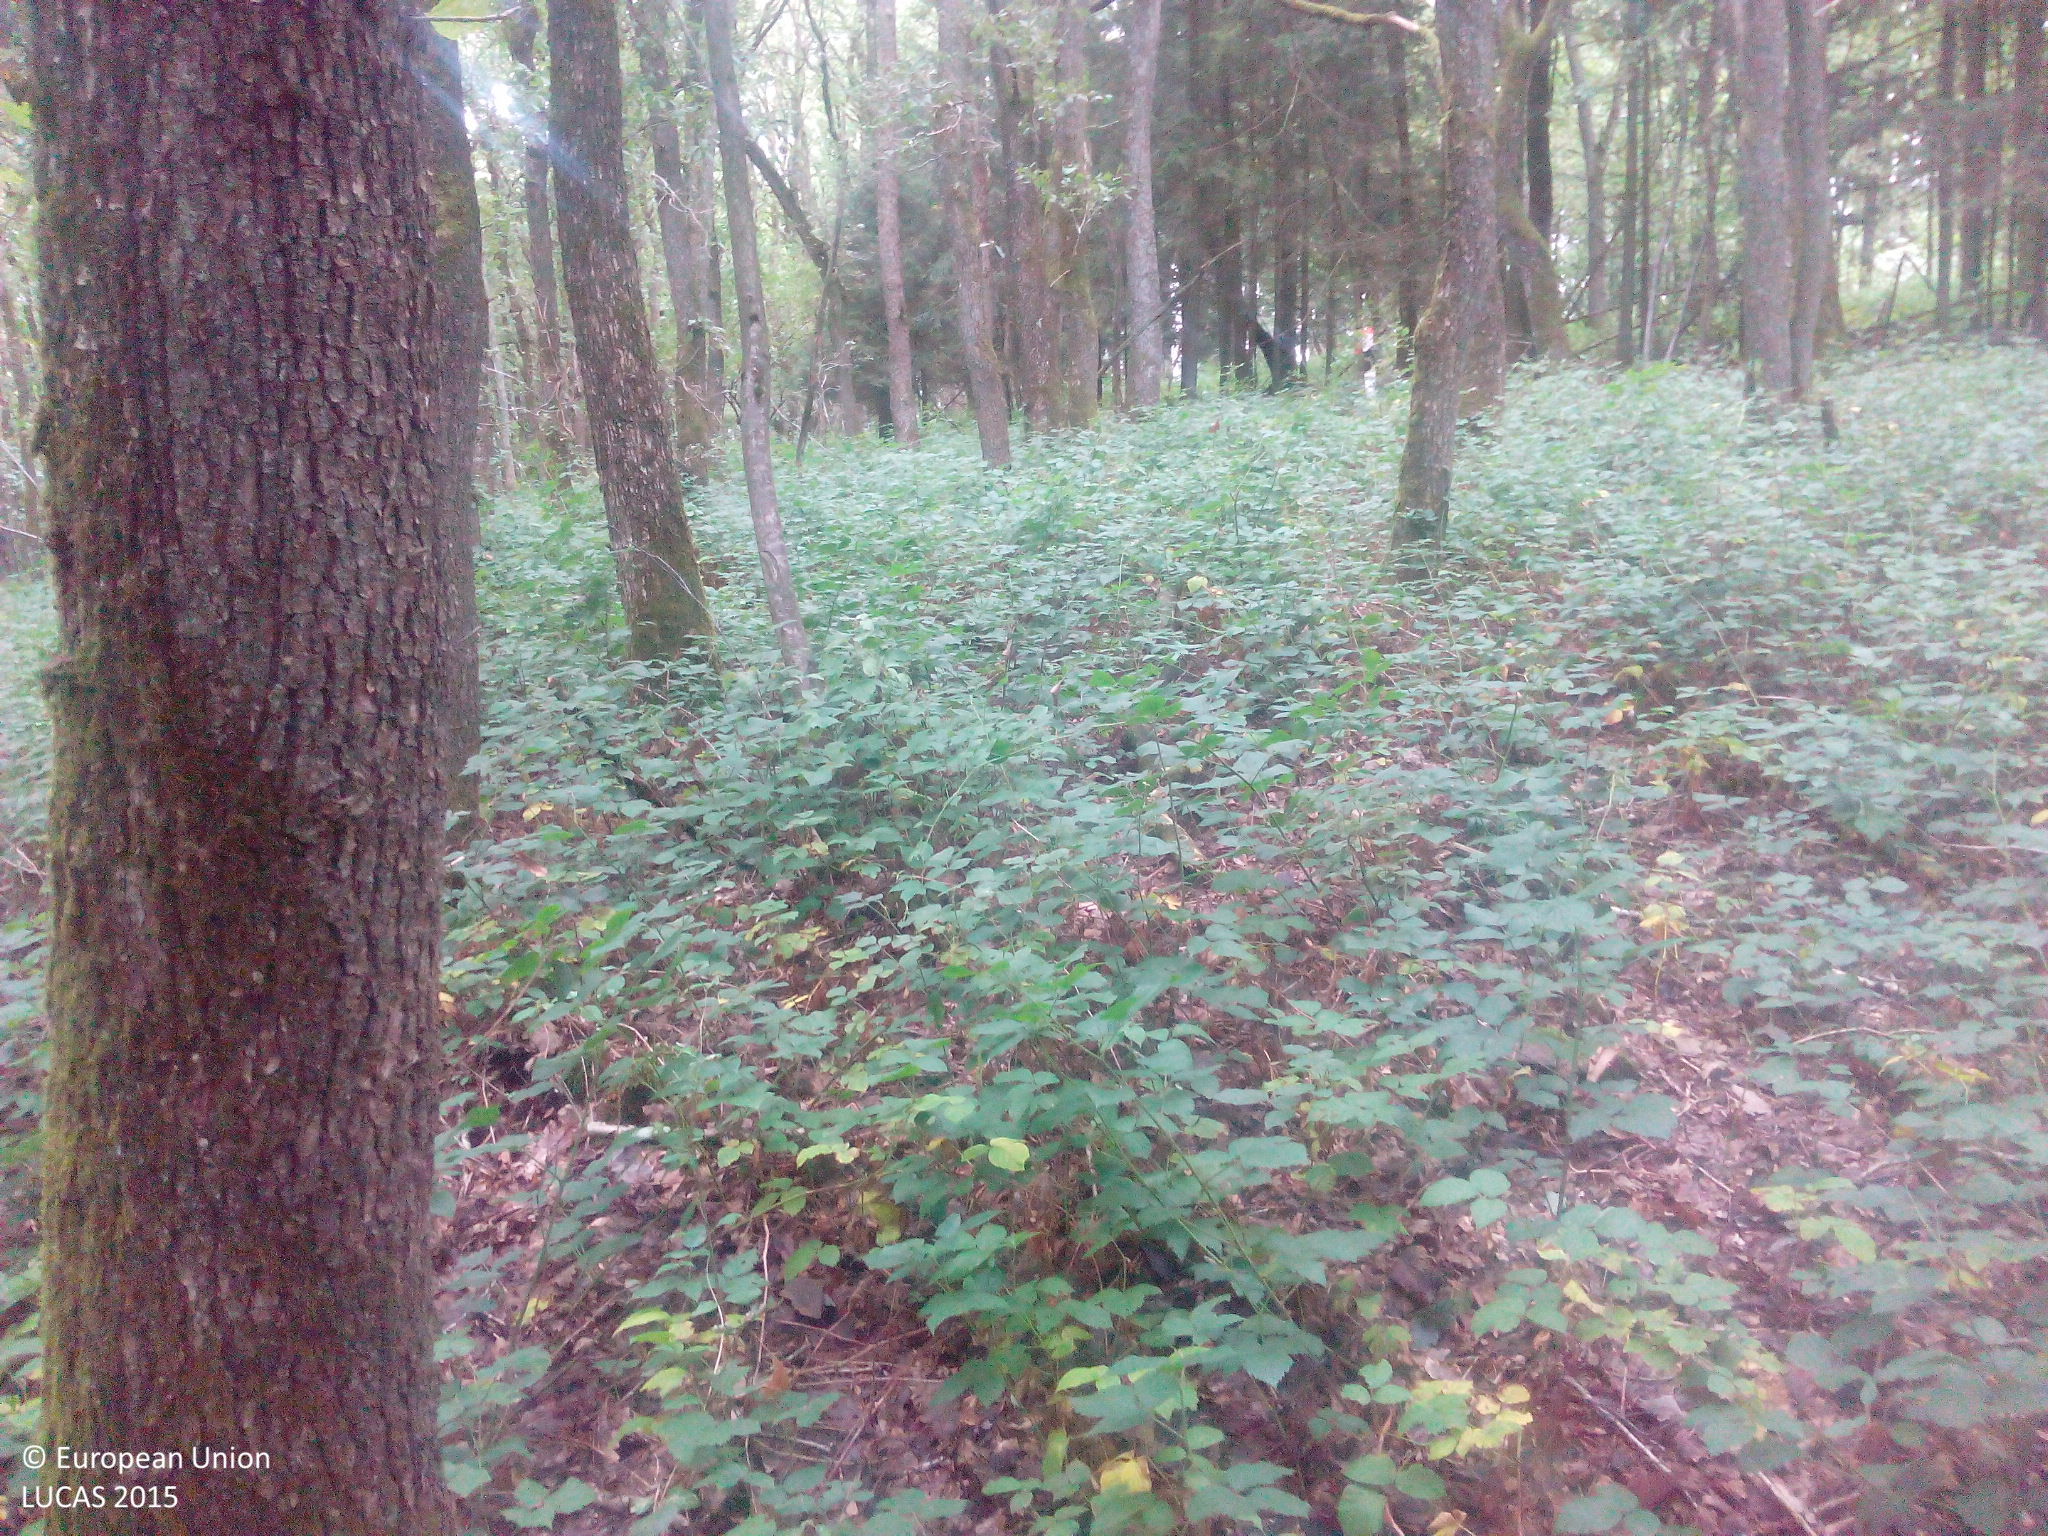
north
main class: Woodland
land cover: Broadleaved woodland
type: mesophytic deciduous forest
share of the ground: > 75 %
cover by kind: broadleaved forest trees 100 %
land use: Forestry
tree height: > 5 m
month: August
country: DE
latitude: 50.1779
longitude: 6.2886
